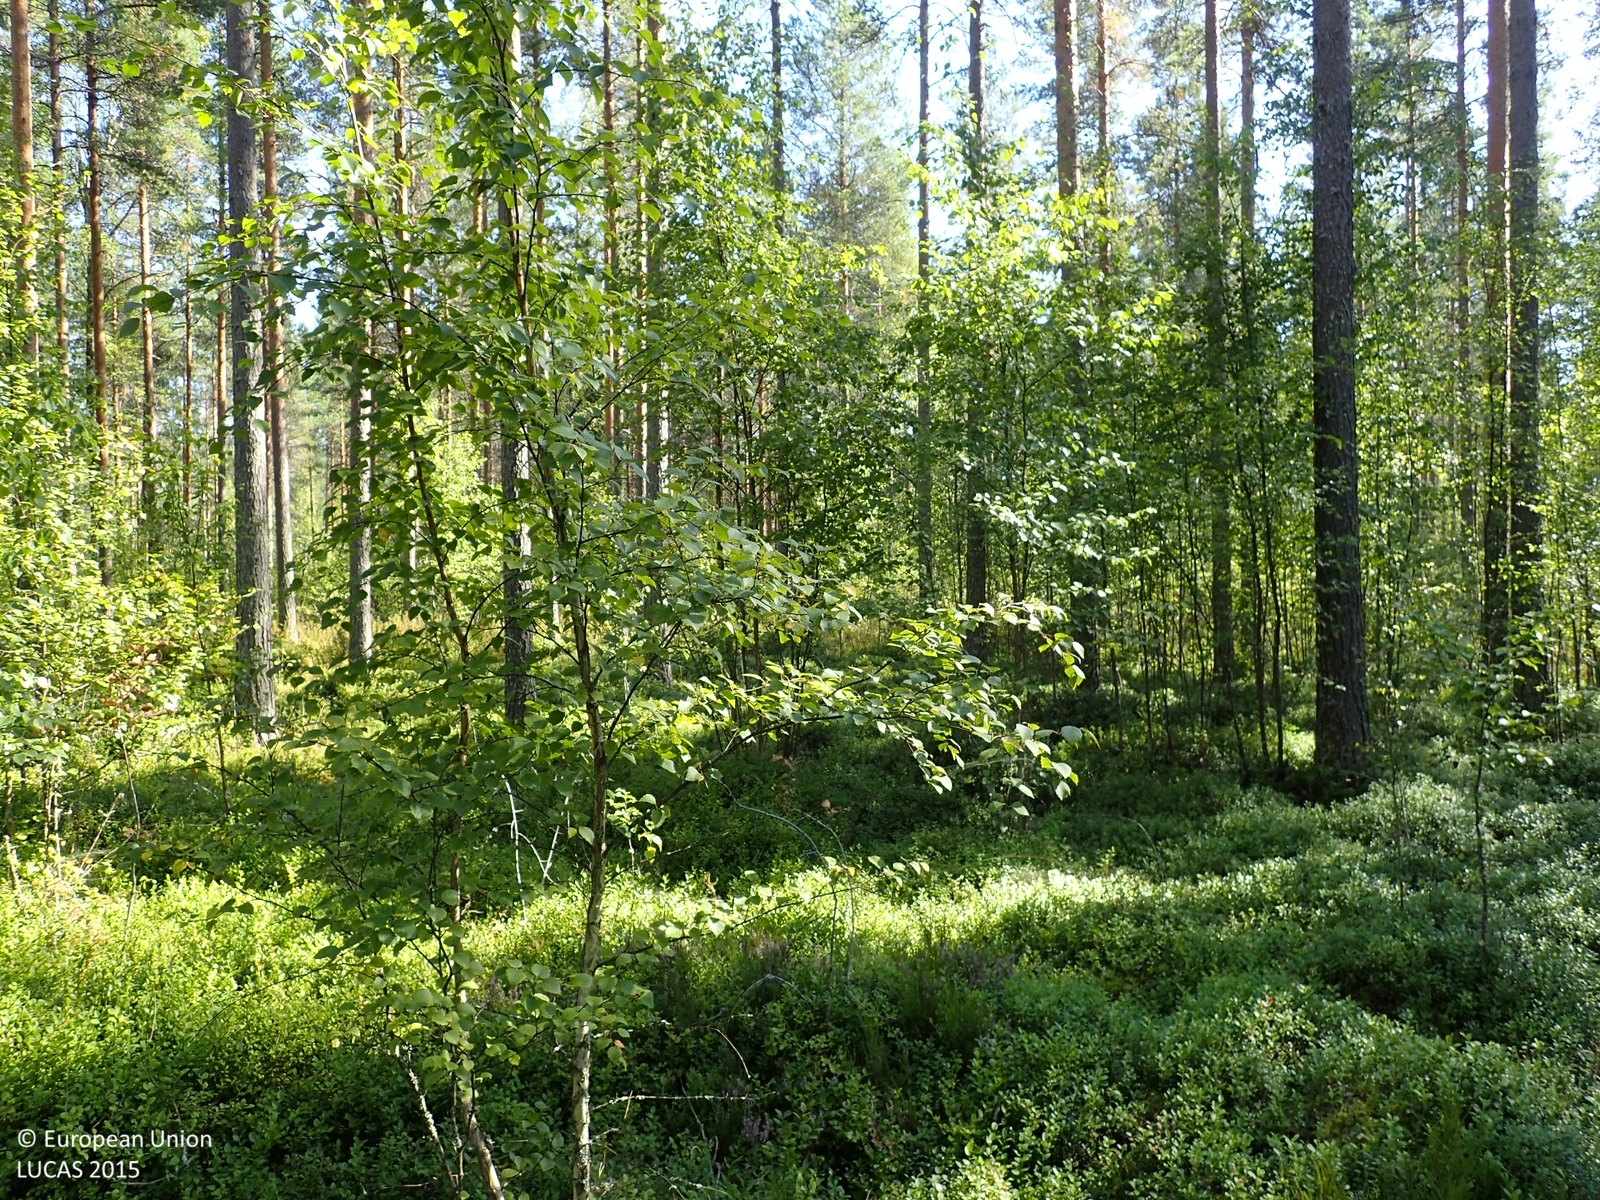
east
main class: Woodland
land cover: Pine dominated mixed woodland
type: boreal forest
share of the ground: 50 - 75 %
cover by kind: coniferous forest trees 45 %, shrubs 40 %, broadleaved forest trees 15 %
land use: Forestry
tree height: > 5 m
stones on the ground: < 10 %
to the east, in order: Pine dominated mixed woodland; Ditches and canals; Pine dominated mixed woodland; Ditches and canals; Pine dominated coniferous woodland; Ditches and canals; Pine dominated coniferous woodland; Ditches and canals; Pine dominated coniferous woodland
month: August
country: FI
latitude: 62.3909
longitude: 21.9446
